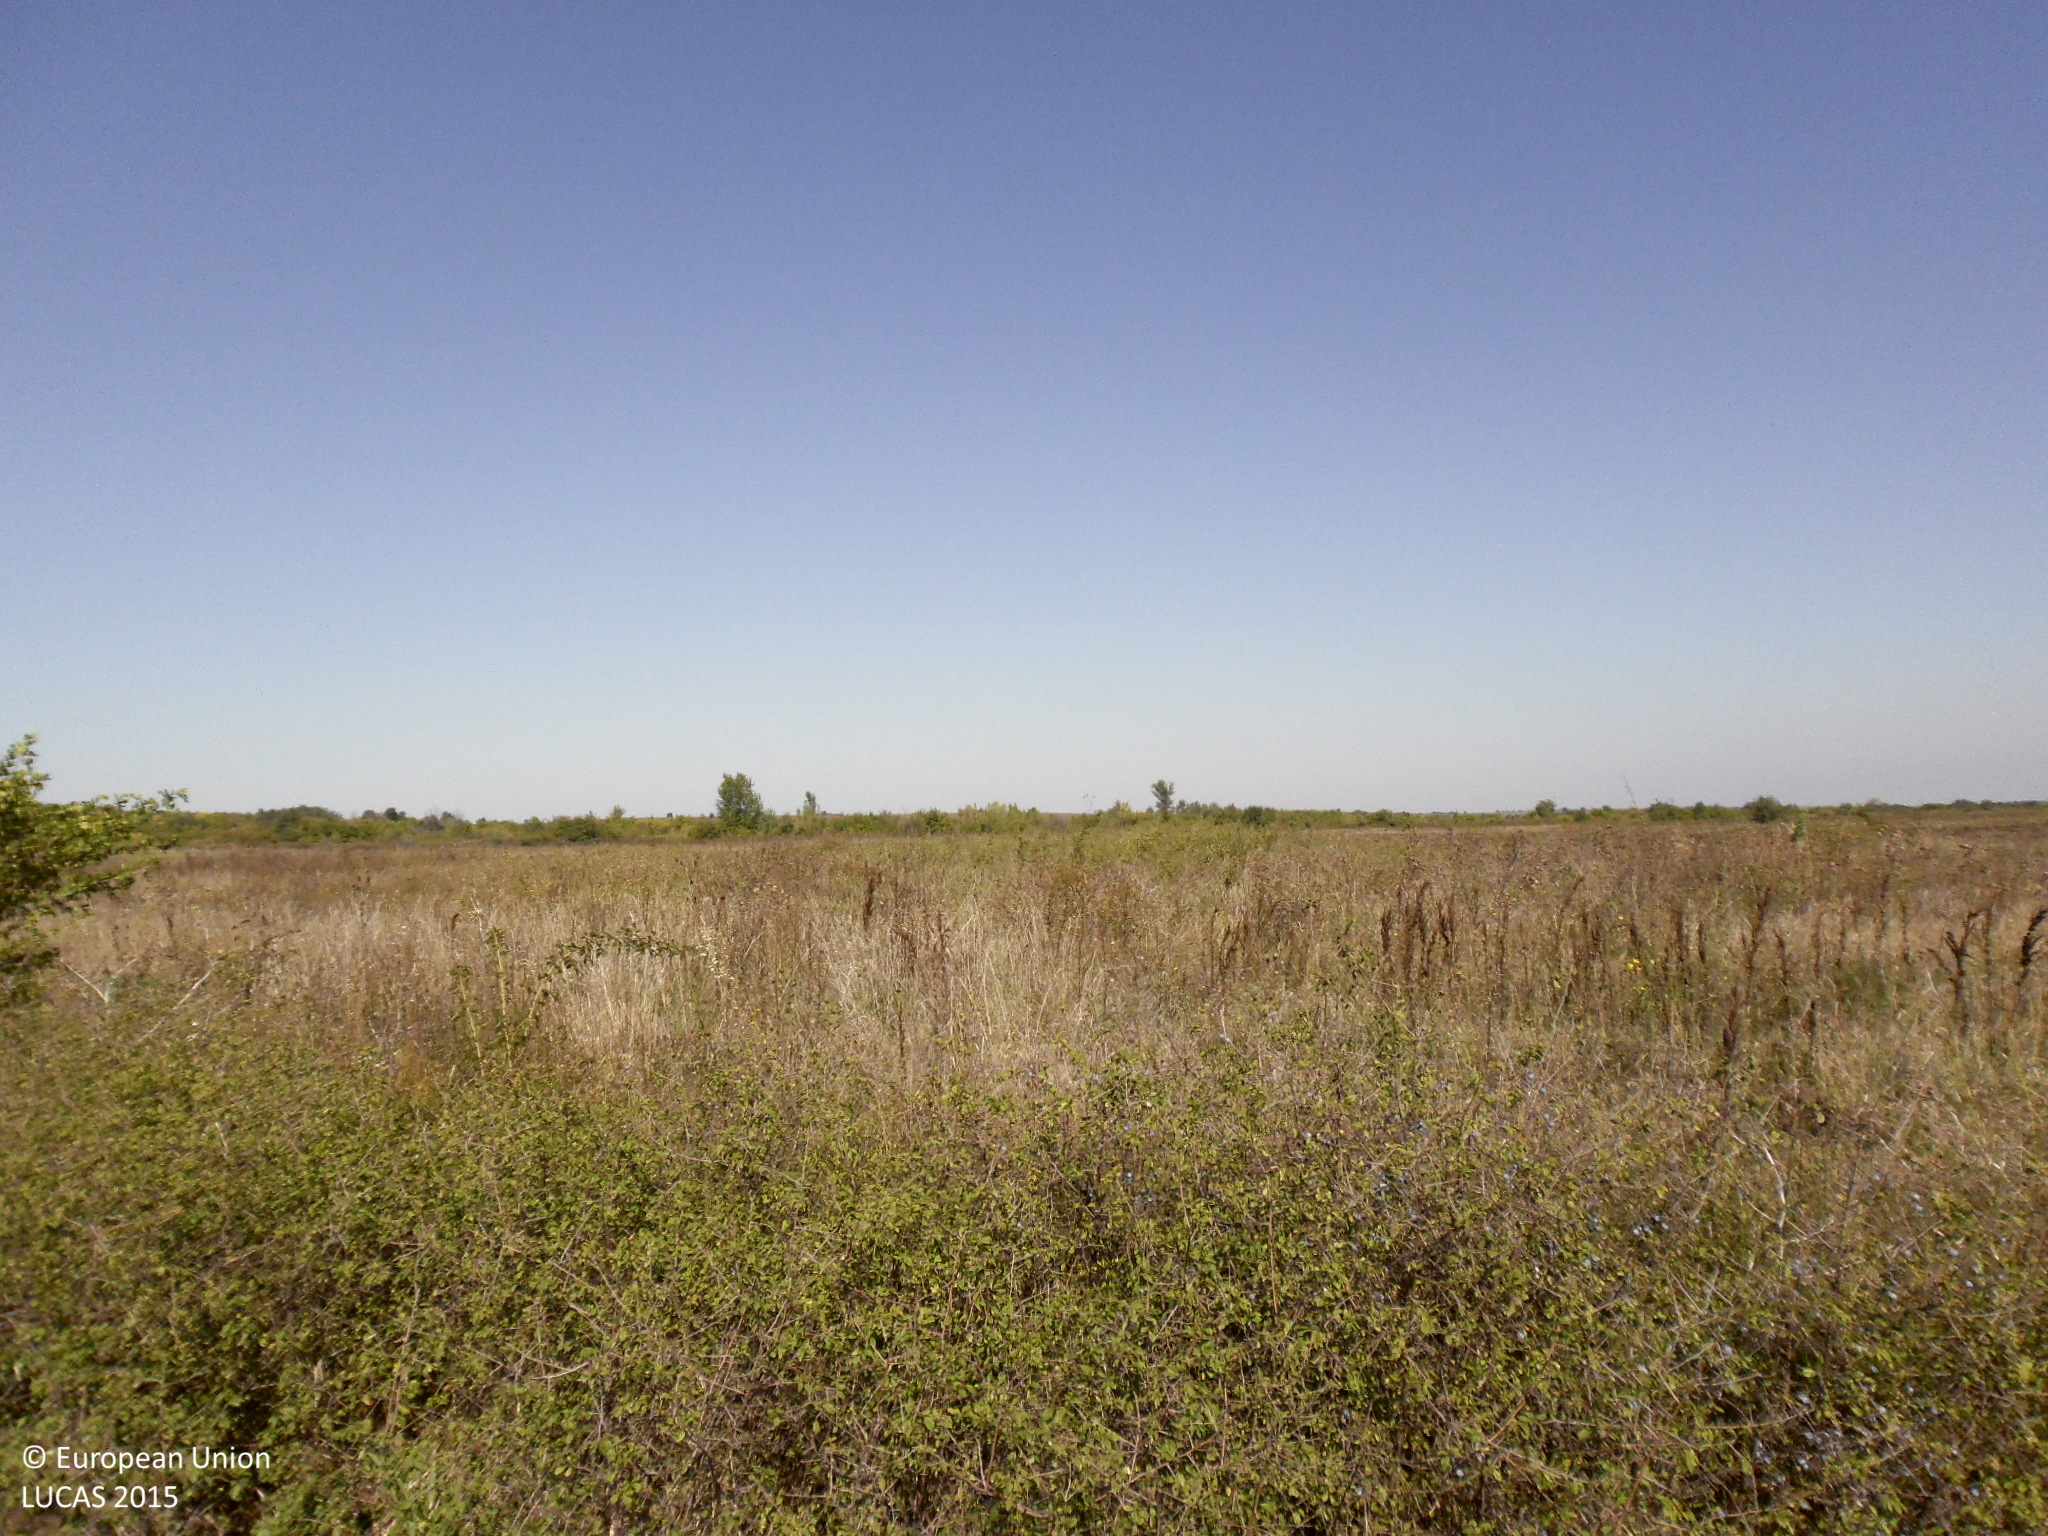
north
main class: Cropland
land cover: Maize
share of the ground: > 75 %
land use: Agriculture (excluding fallow land and kitchen gardens)
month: October
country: BG
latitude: 43.6549
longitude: 22.8699
